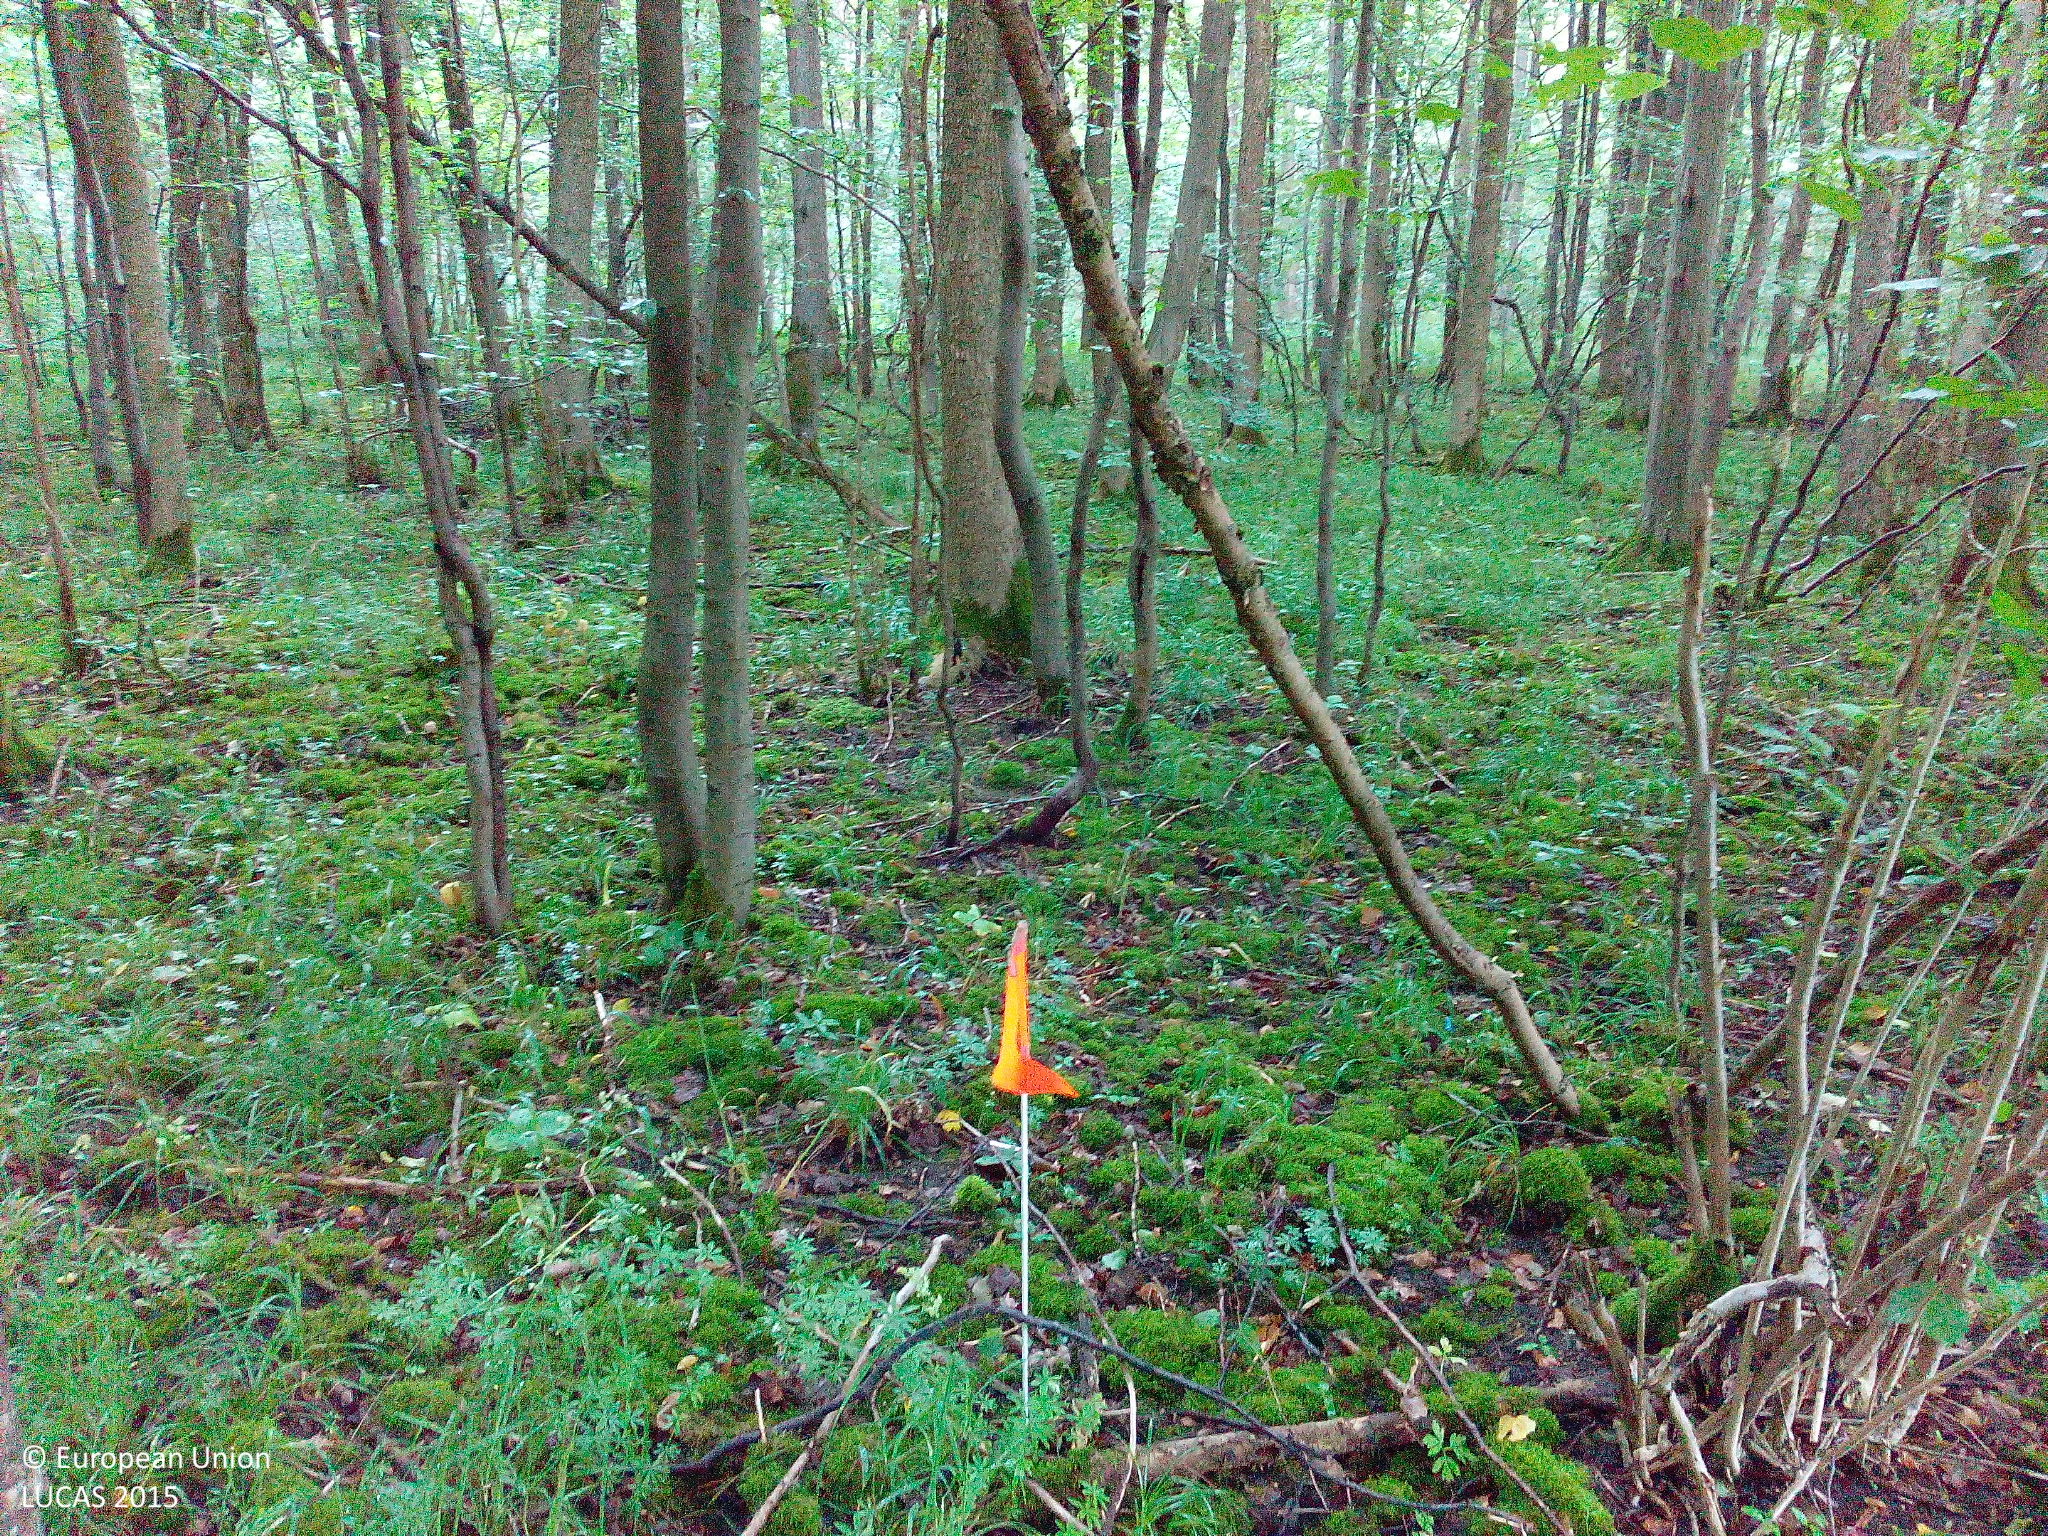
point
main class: Woodland
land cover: Broadleaved woodland
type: acidophilous oak and oak-birch forest
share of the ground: > 75 %
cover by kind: broadleaved forest trees 100 %
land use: Forestry
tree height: > 5 m
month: July
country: DE
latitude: 50.6696
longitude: 9.8727
